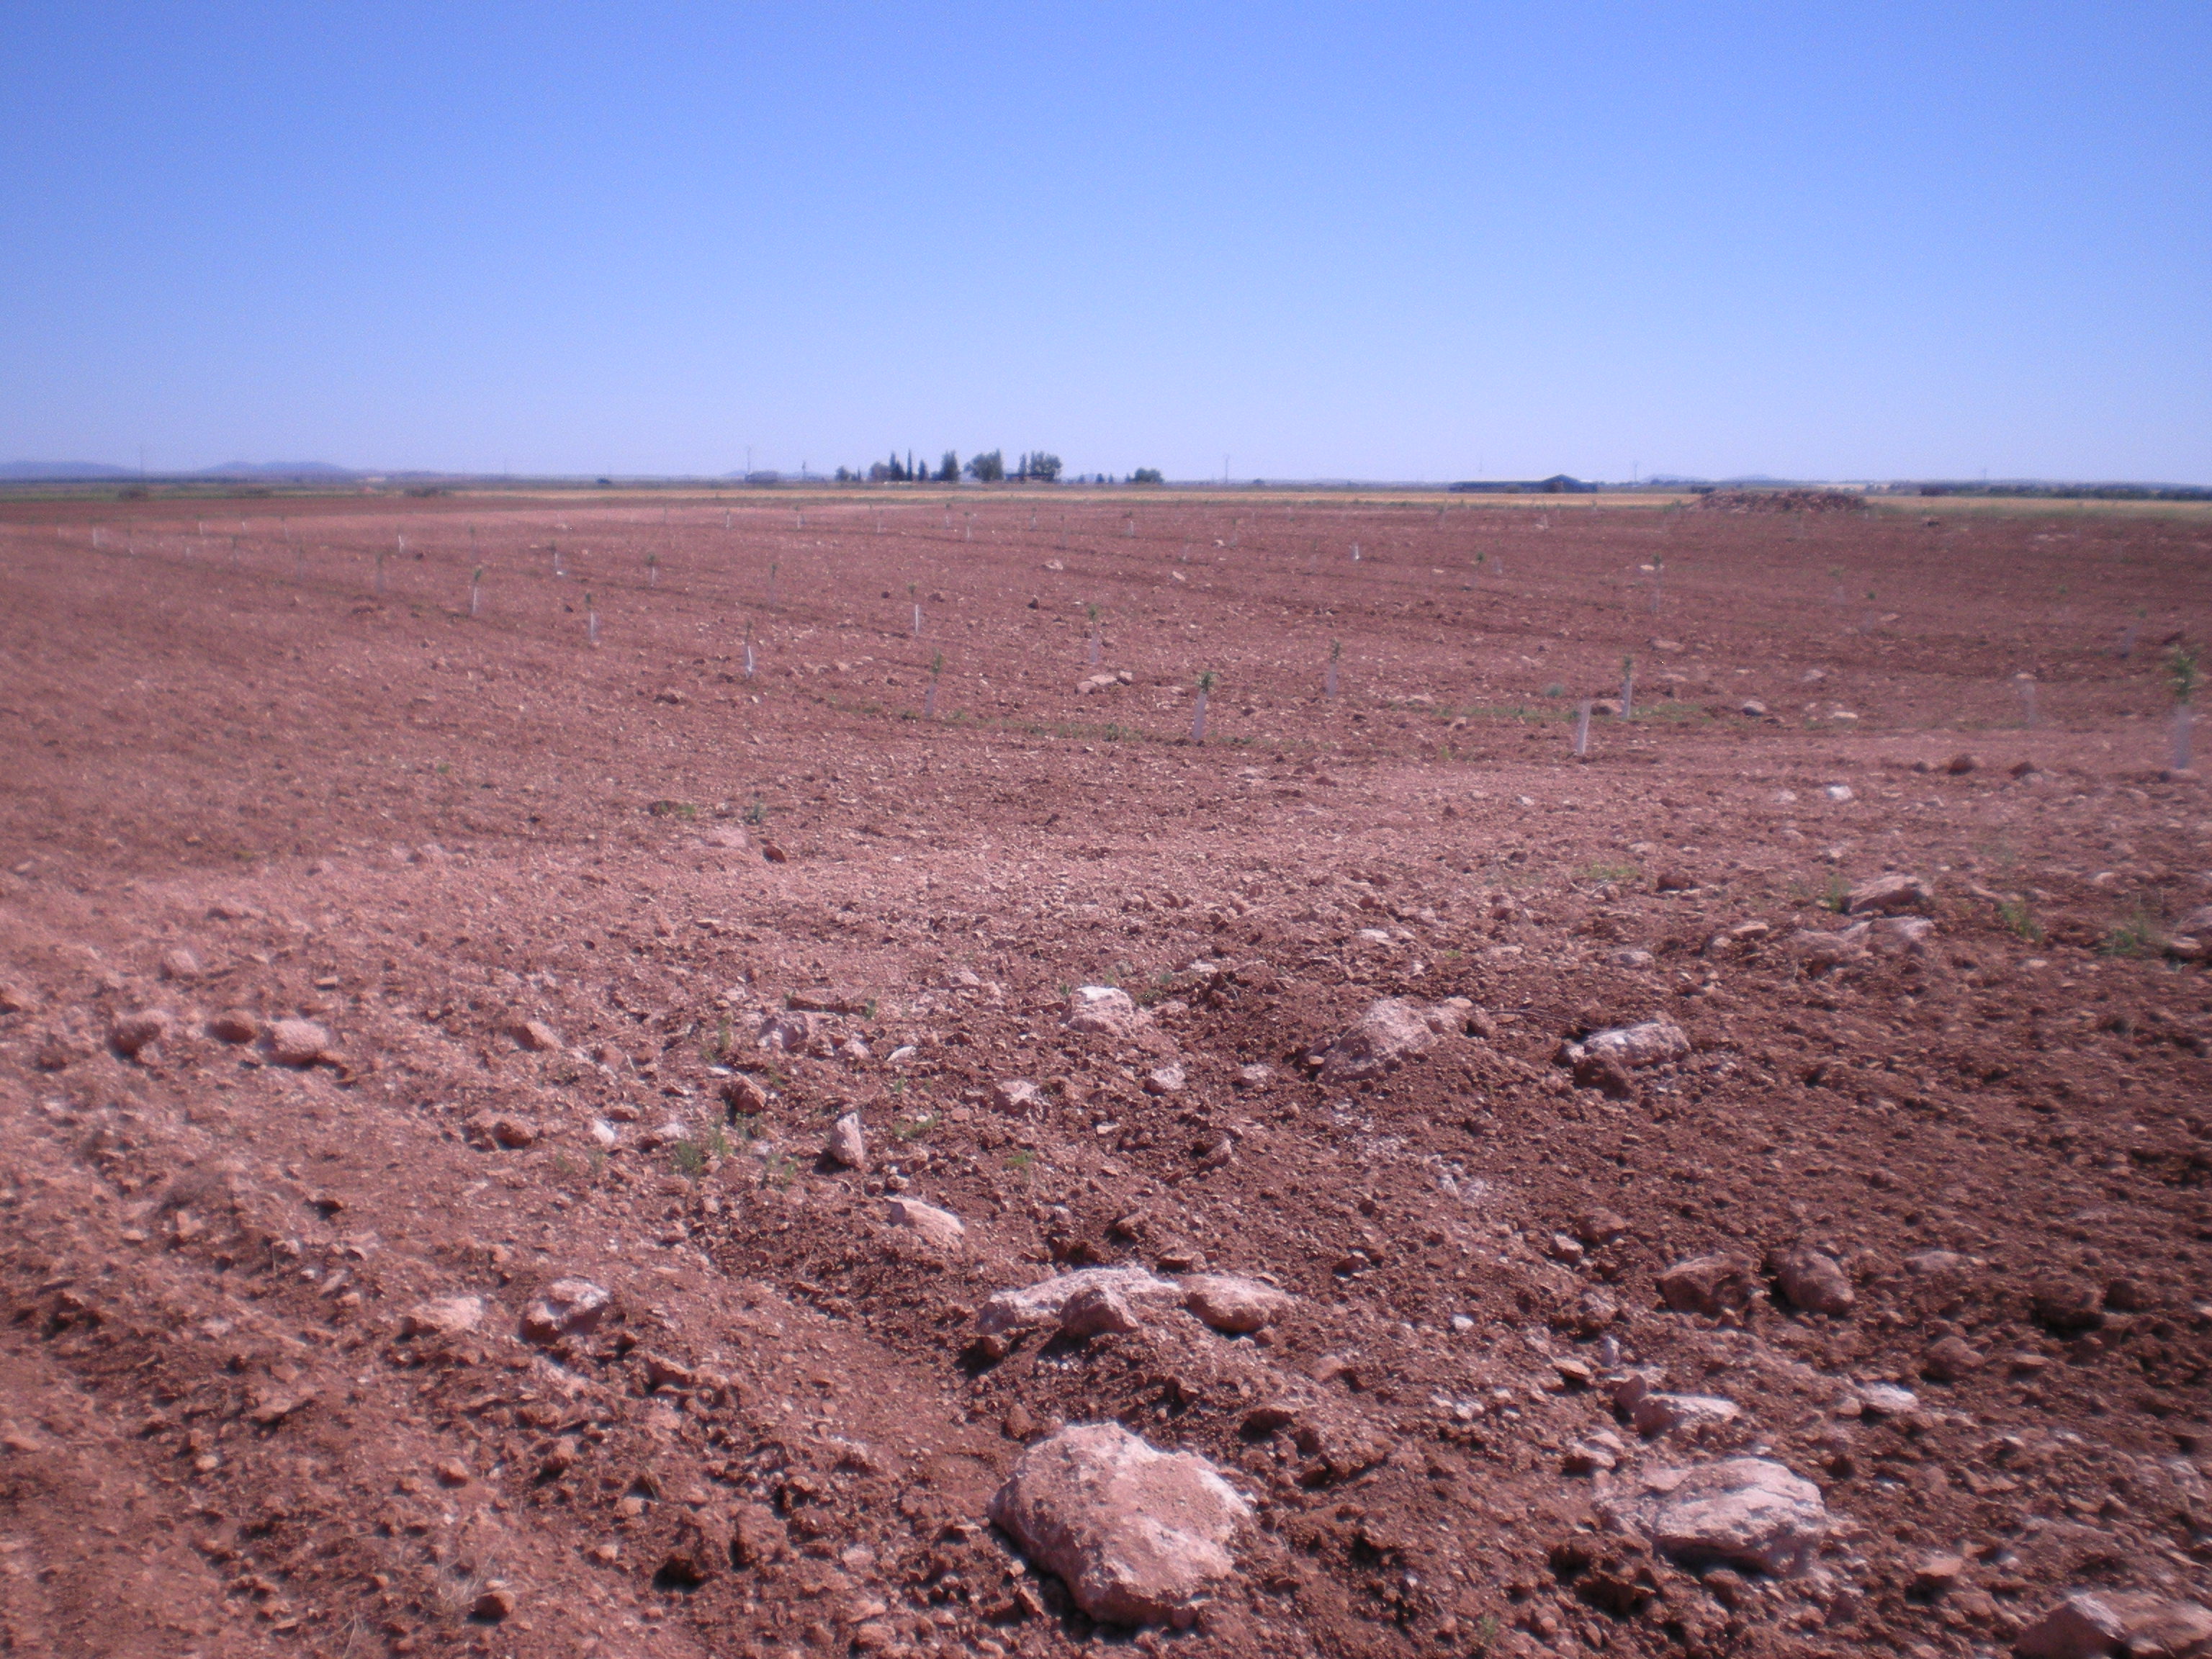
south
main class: Cropland
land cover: Nuts trees
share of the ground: < 10 %
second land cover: Other bare soil
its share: > 75 %
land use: Agriculture (excluding fallow land and kitchen gardens)
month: May
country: ES
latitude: 39.0956
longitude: -3.2063
